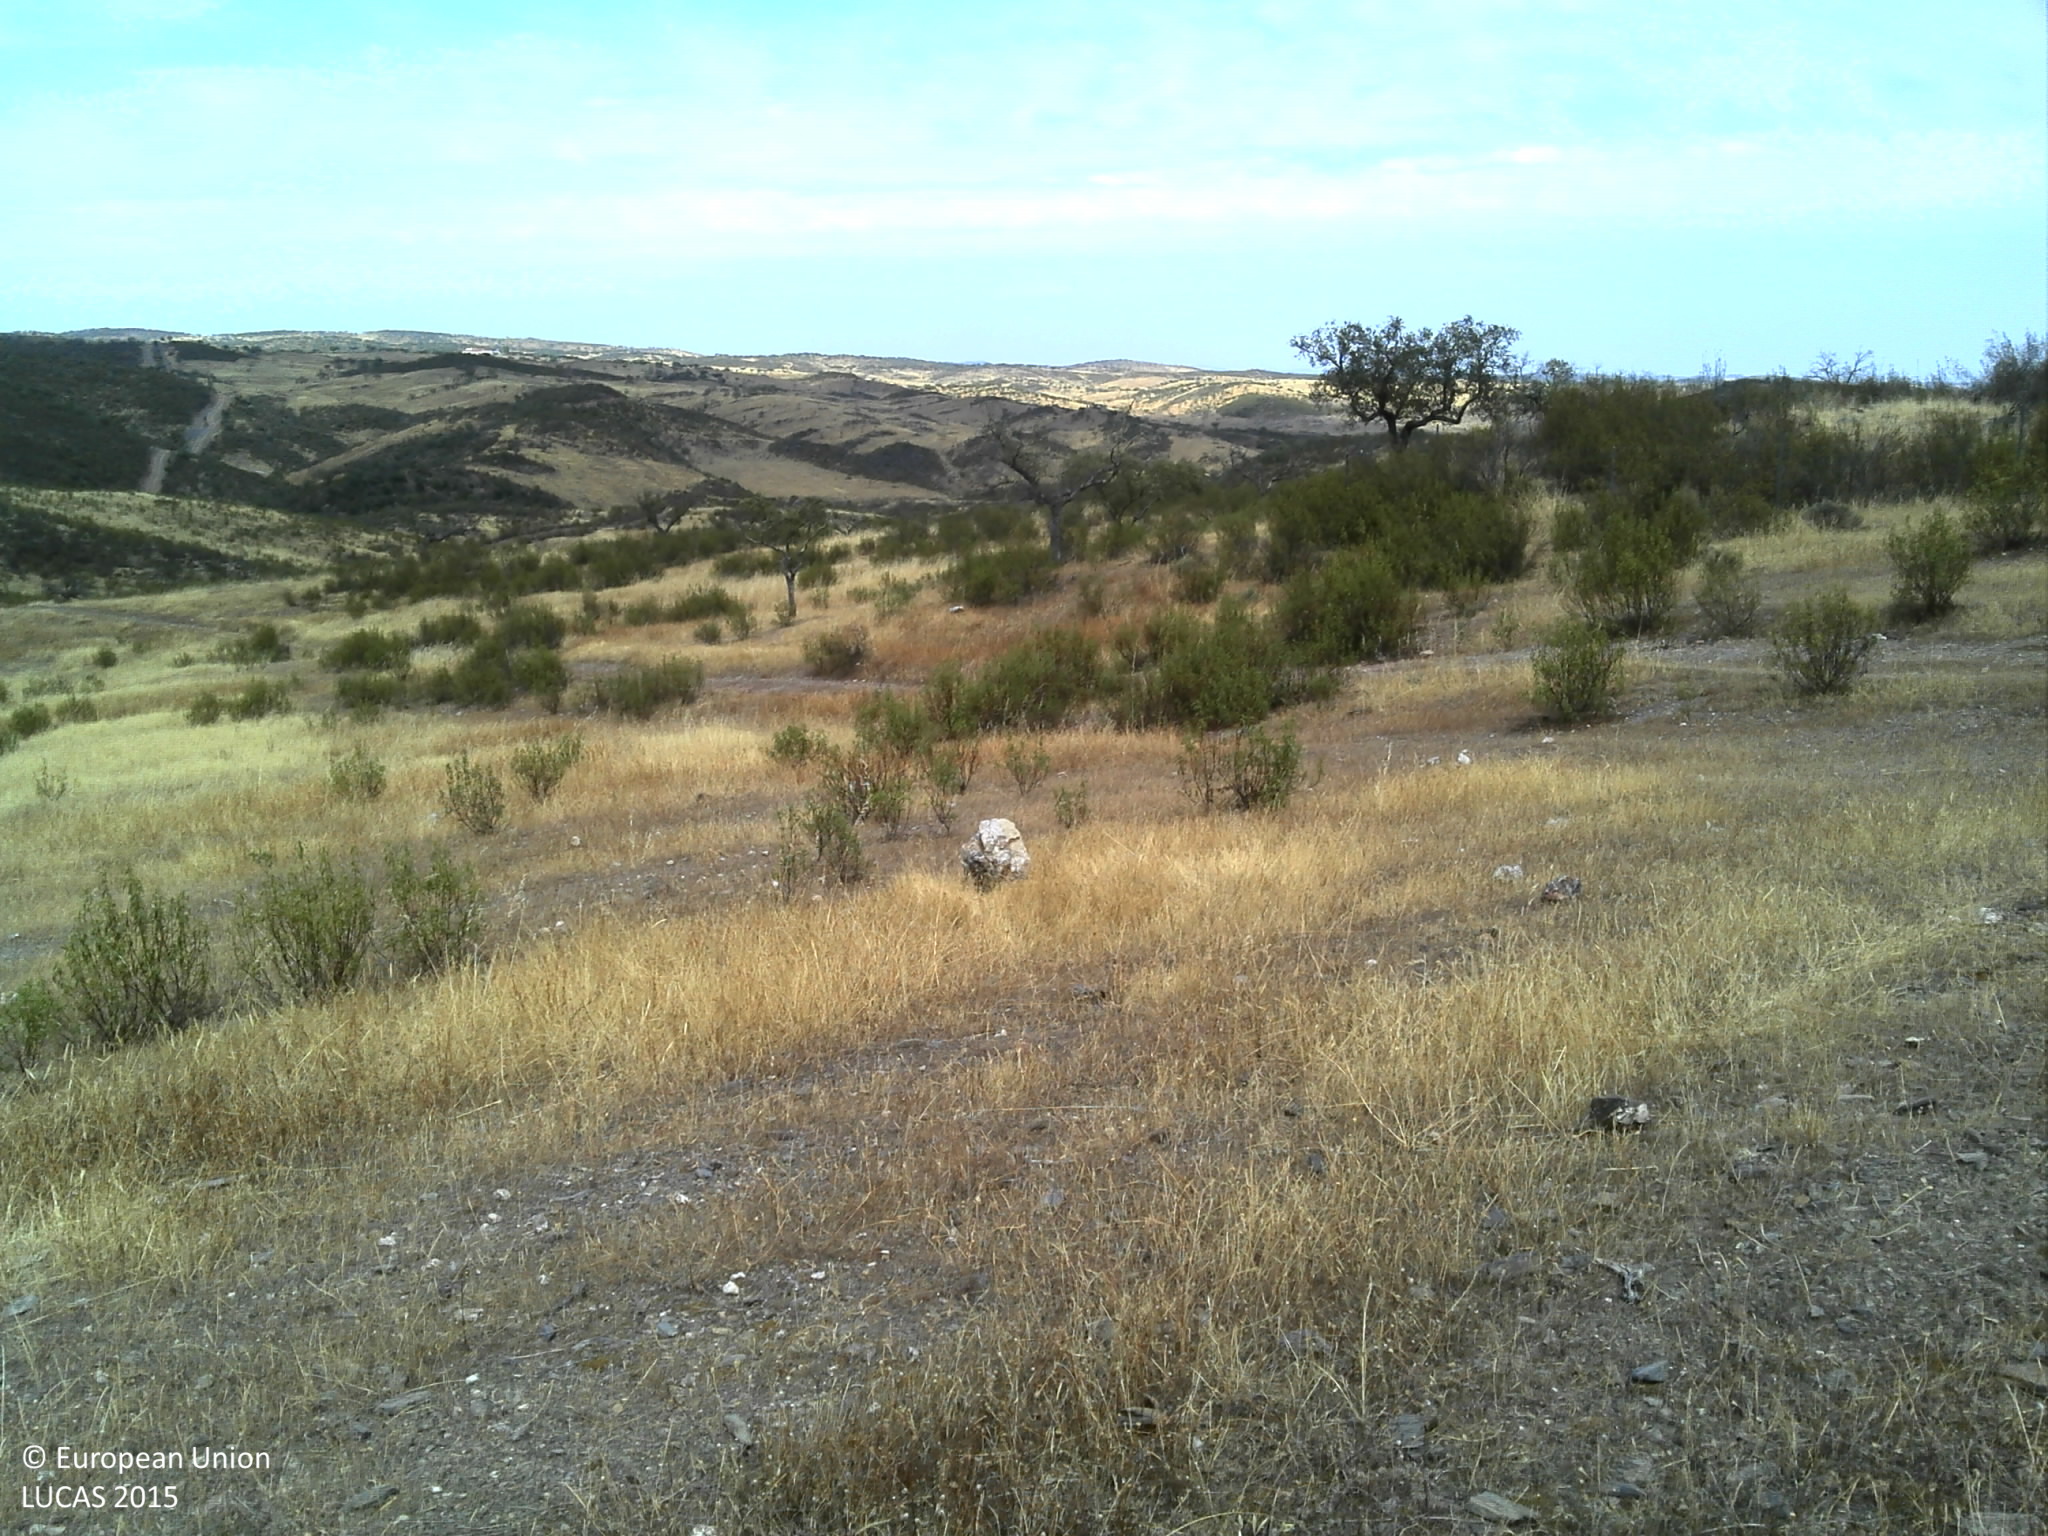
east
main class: Grassland
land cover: Grassland with sparse tree/shrub cover
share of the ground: 50 - 75 %
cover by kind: herbaceous plants 60 %, unconsolidated bare surface 30 %, broadleaved forest trees 5 %, shrubs 5 %
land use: Agriculture (excluding fallow land and kitchen gardens)
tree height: < 5 m
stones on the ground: < 10 %
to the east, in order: Grassland with sparse tree/shrub cover; Grassland without tree/shrub cover; Tracks; Shrubland without tree cover; Tracks; Grass margins; Fences; Shrubland without tree cover; Fences; Grass margins; Tracks; Grassland without tree/shrub cover; Shrubland with sparse tree cover; Grassland without tree/shrub cover; Shrubland without tree cover
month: July
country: PT
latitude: 38.1156
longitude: -7.1570
